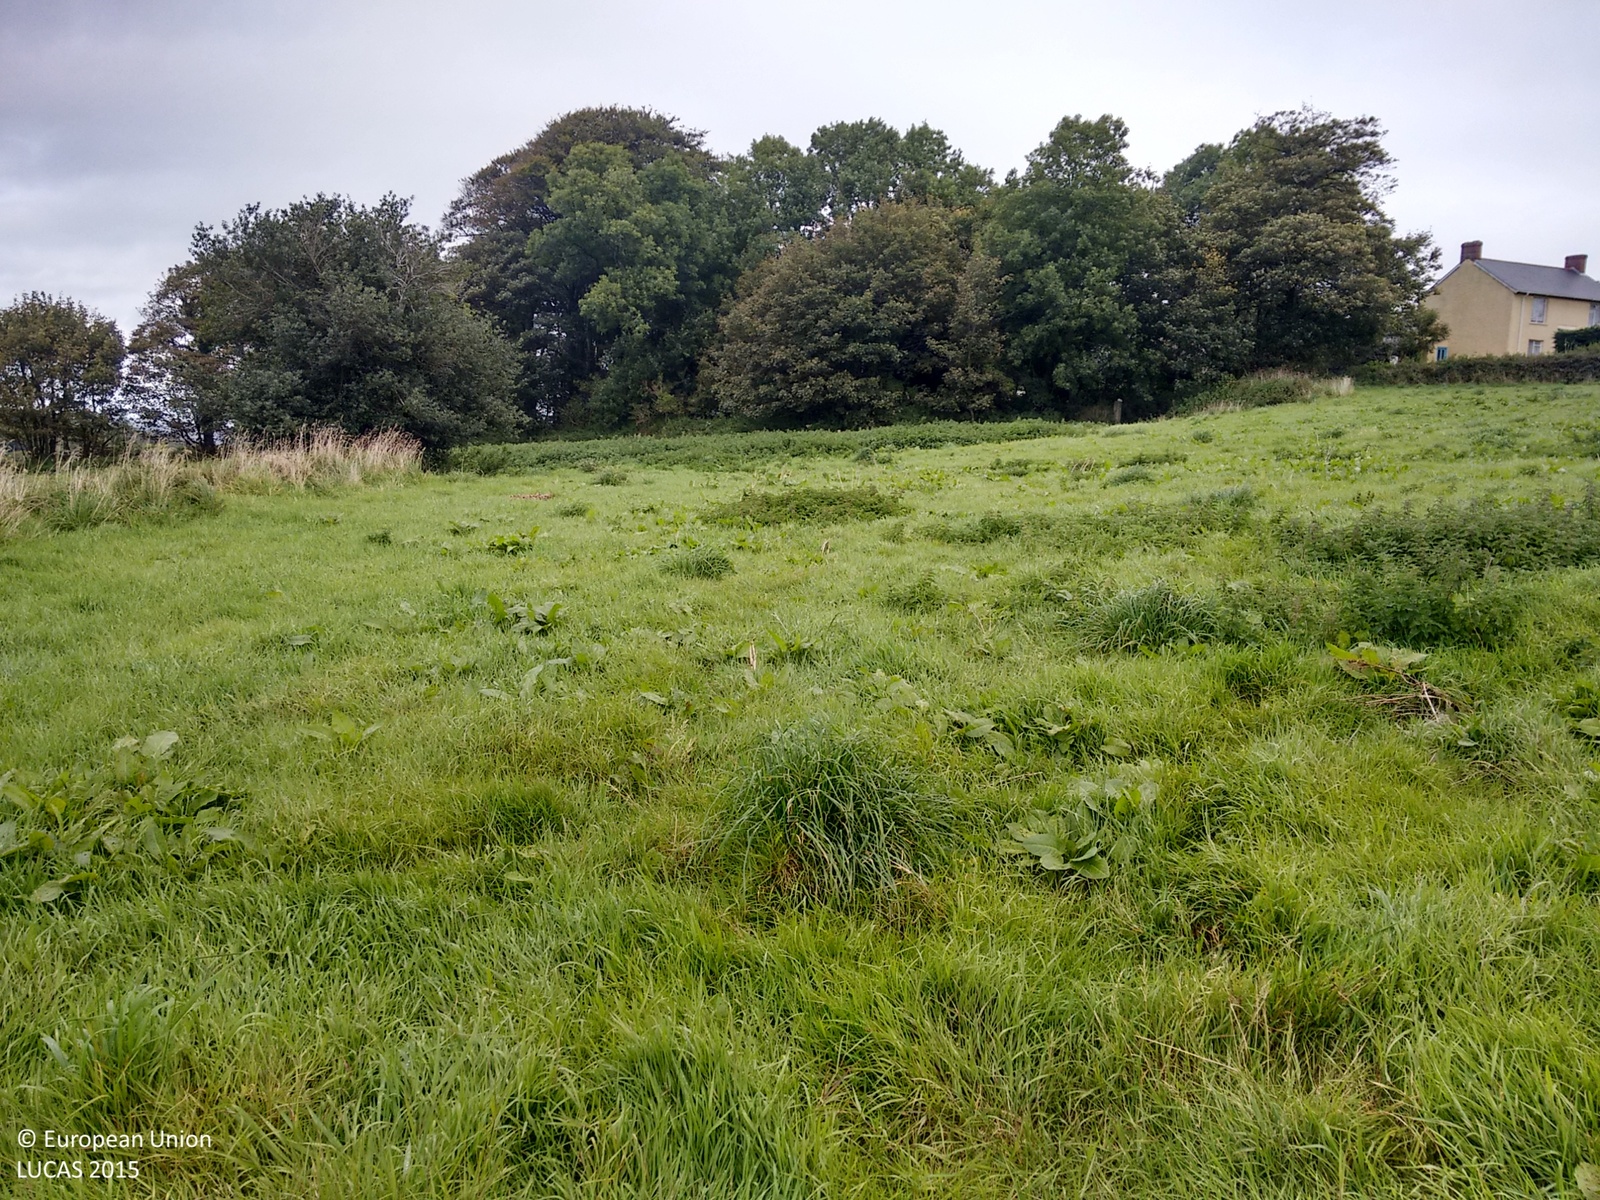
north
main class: Grassland
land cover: Grassland without tree/shrub cover
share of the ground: > 75 %
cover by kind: herbaceous plants 100 %
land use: Agriculture (excluding fallow land and kitchen gardens)
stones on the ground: < 10 %
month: September
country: GB
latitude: 50.6029
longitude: -4.2133
